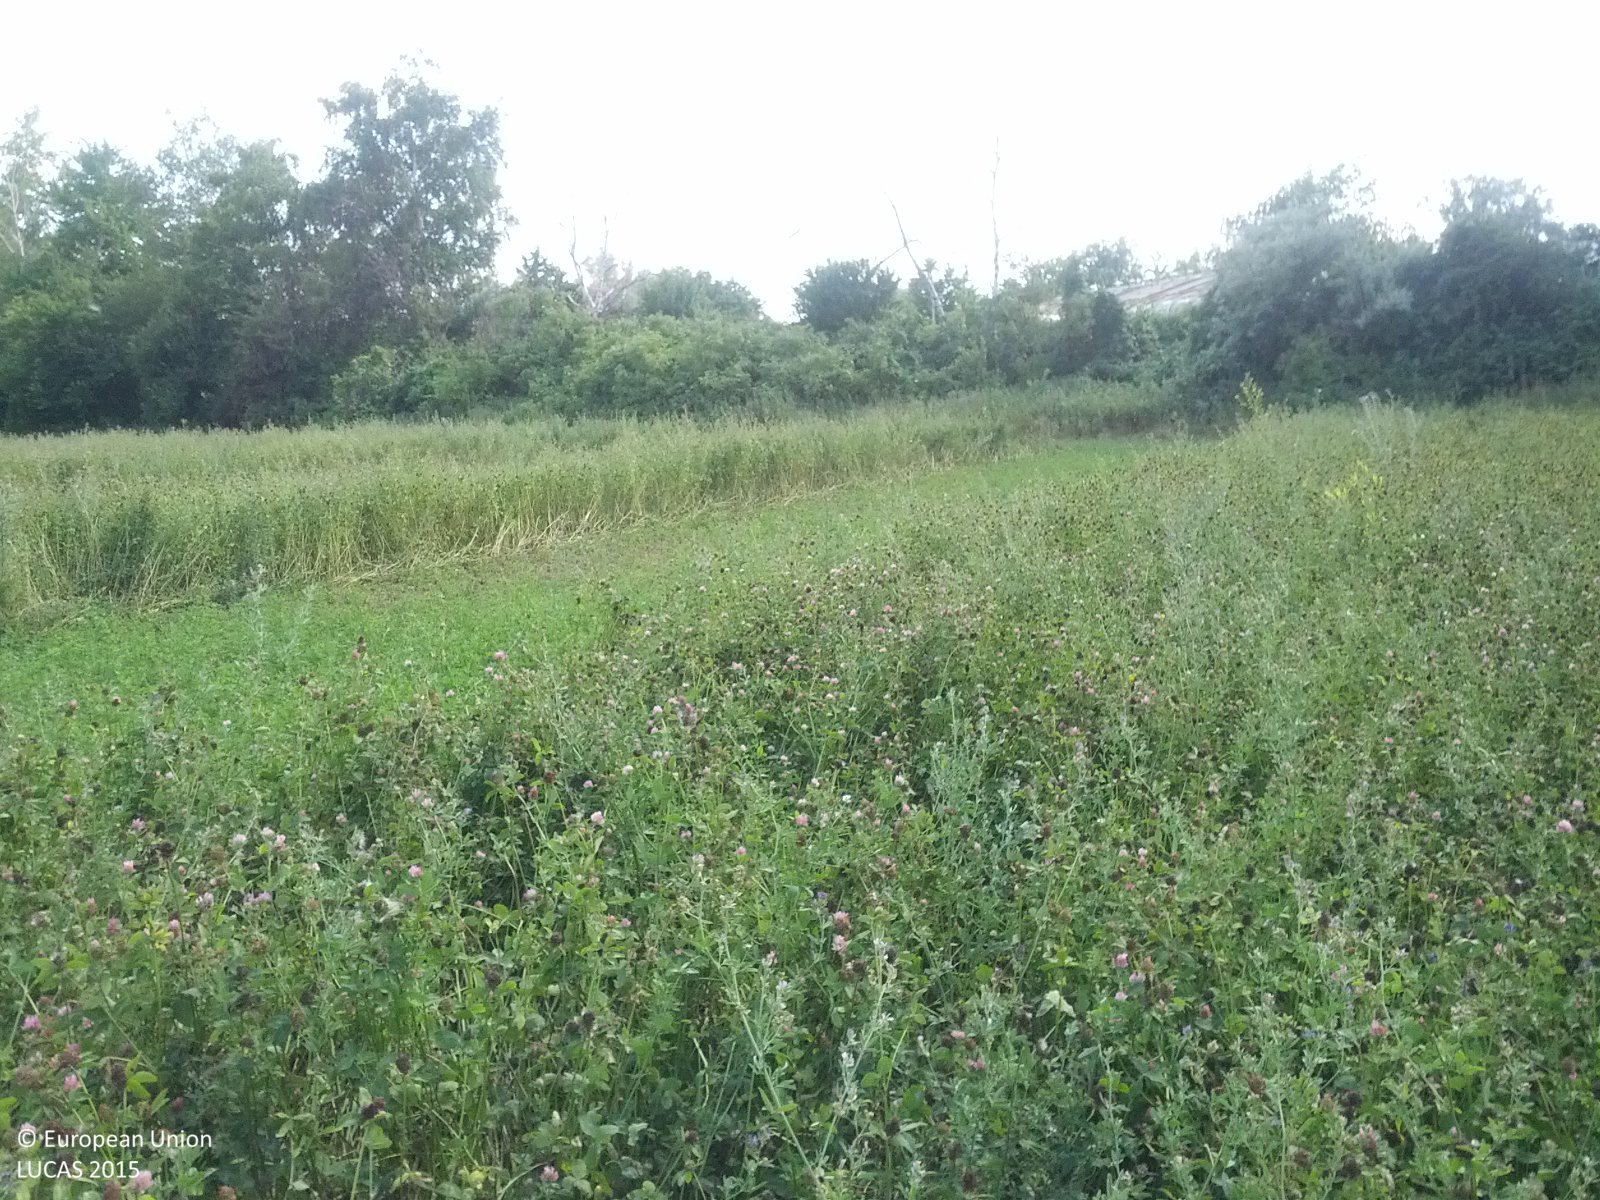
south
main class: Cropland
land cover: Clovers
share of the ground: > 75 %
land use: Agriculture (excluding fallow land and kitchen gardens)
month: June
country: AT
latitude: 48.3797
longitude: 16.7171
